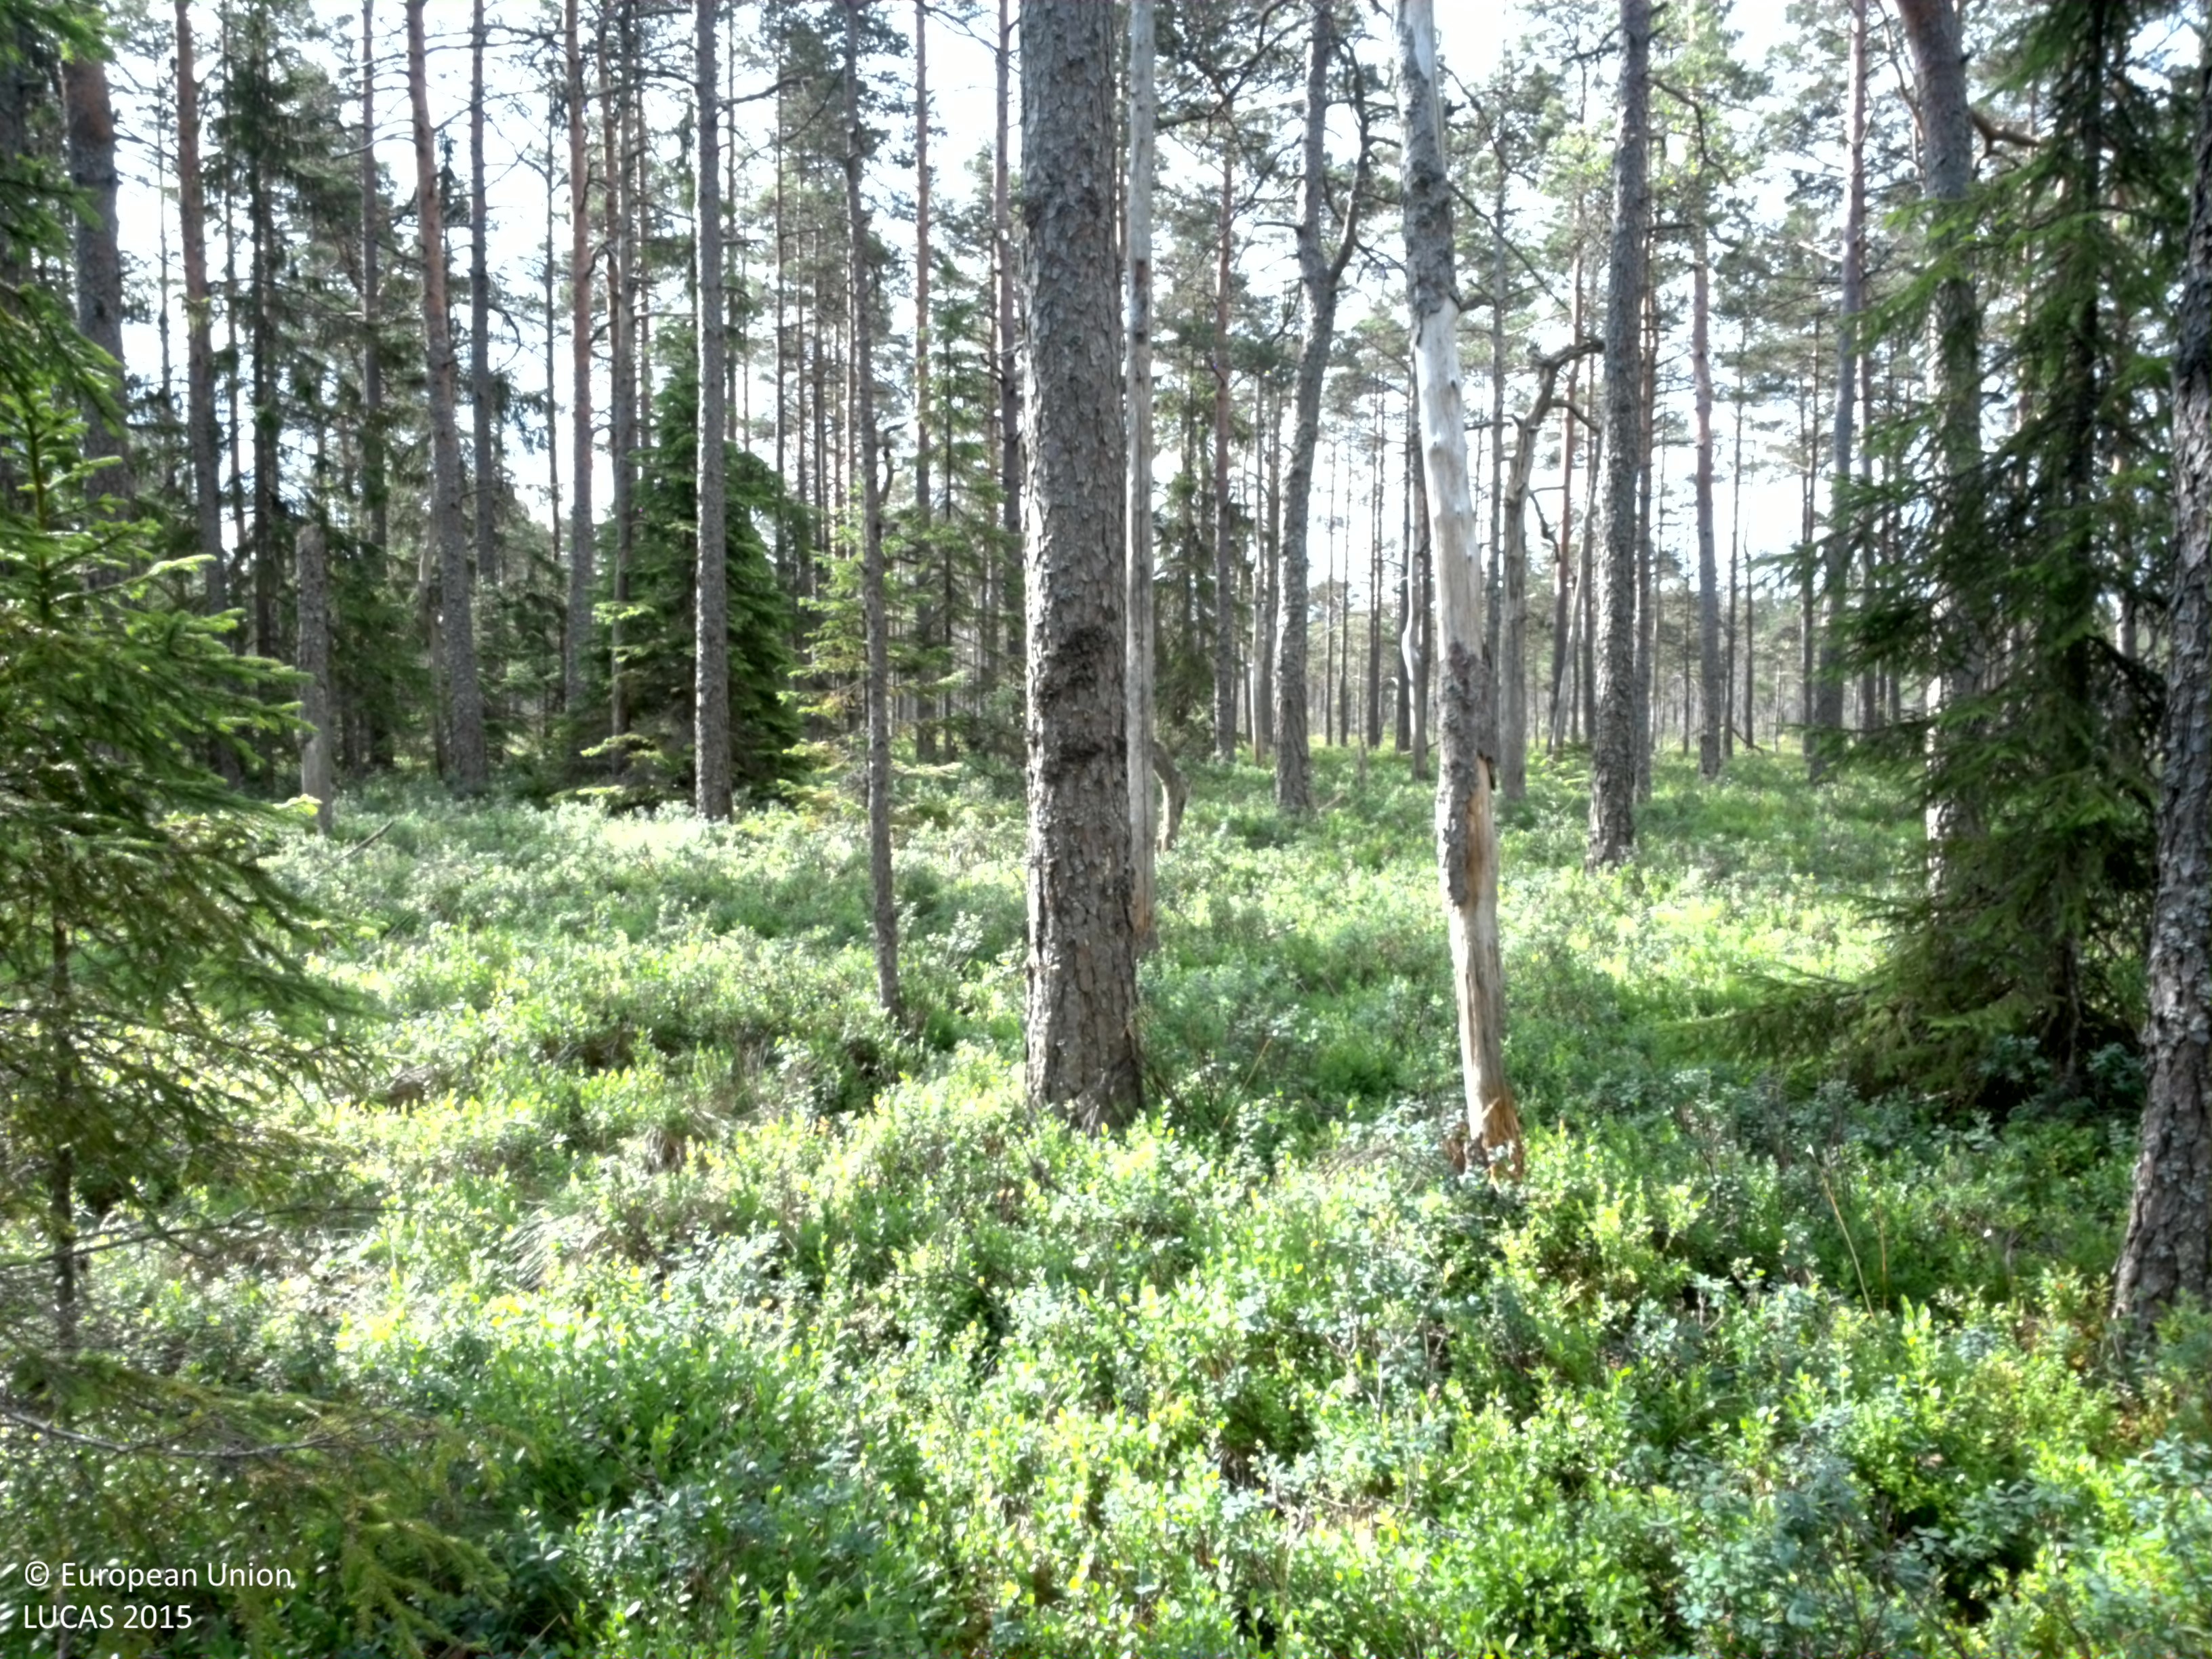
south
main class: Woodland
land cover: Pine dominated coniferous woodland
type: boreal forest
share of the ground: 50 - 75 %
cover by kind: coniferous forest trees 70 %, shrubs 15 %, lichens and mosses 15 %
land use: Forestry
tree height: > 5 m
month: July
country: SE
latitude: 57.5657
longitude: 14.5594
